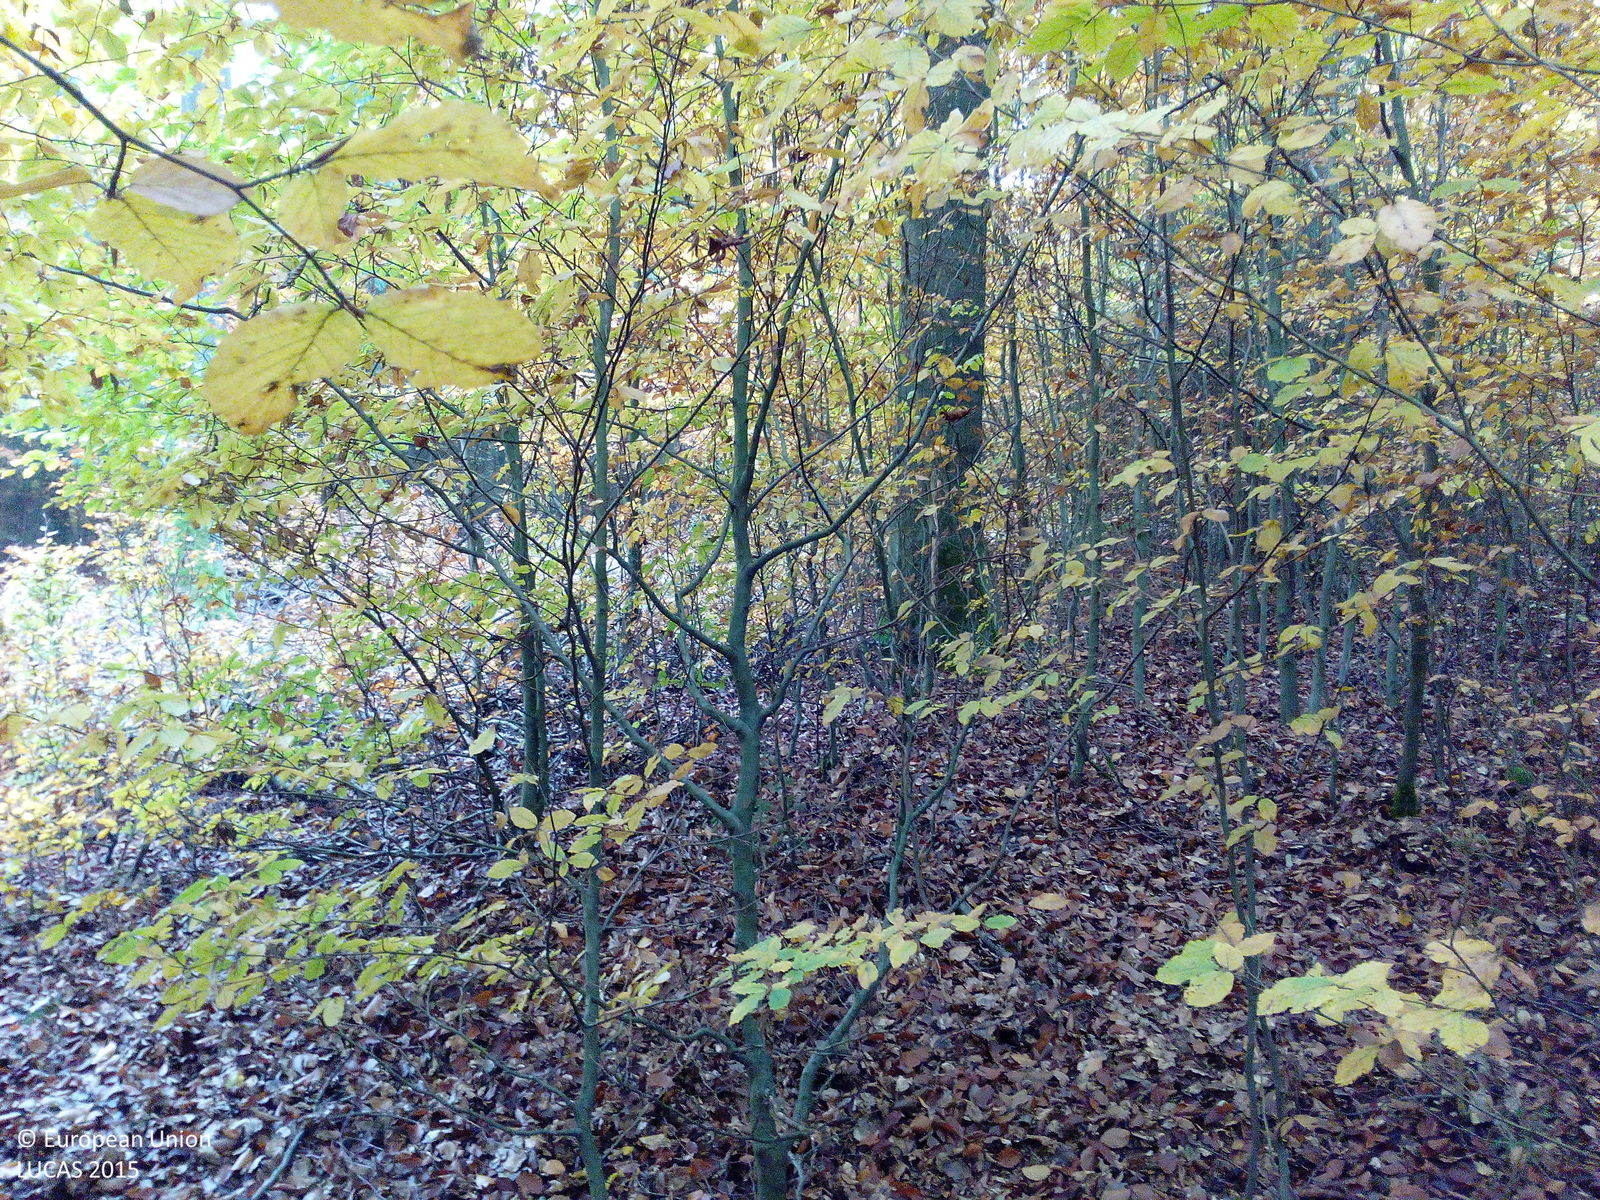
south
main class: Woodland
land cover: Broadleaved woodland
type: mesophytic deciduous forest
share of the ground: > 75 %
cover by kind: broadleaved forest trees 70 %, unconsolidated bare surface 15 %, coniferous forest trees 10 %, lichens and mosses 5 %
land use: Forestry
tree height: > 5 m
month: October
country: DE
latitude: 50.2561
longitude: 9.9019
